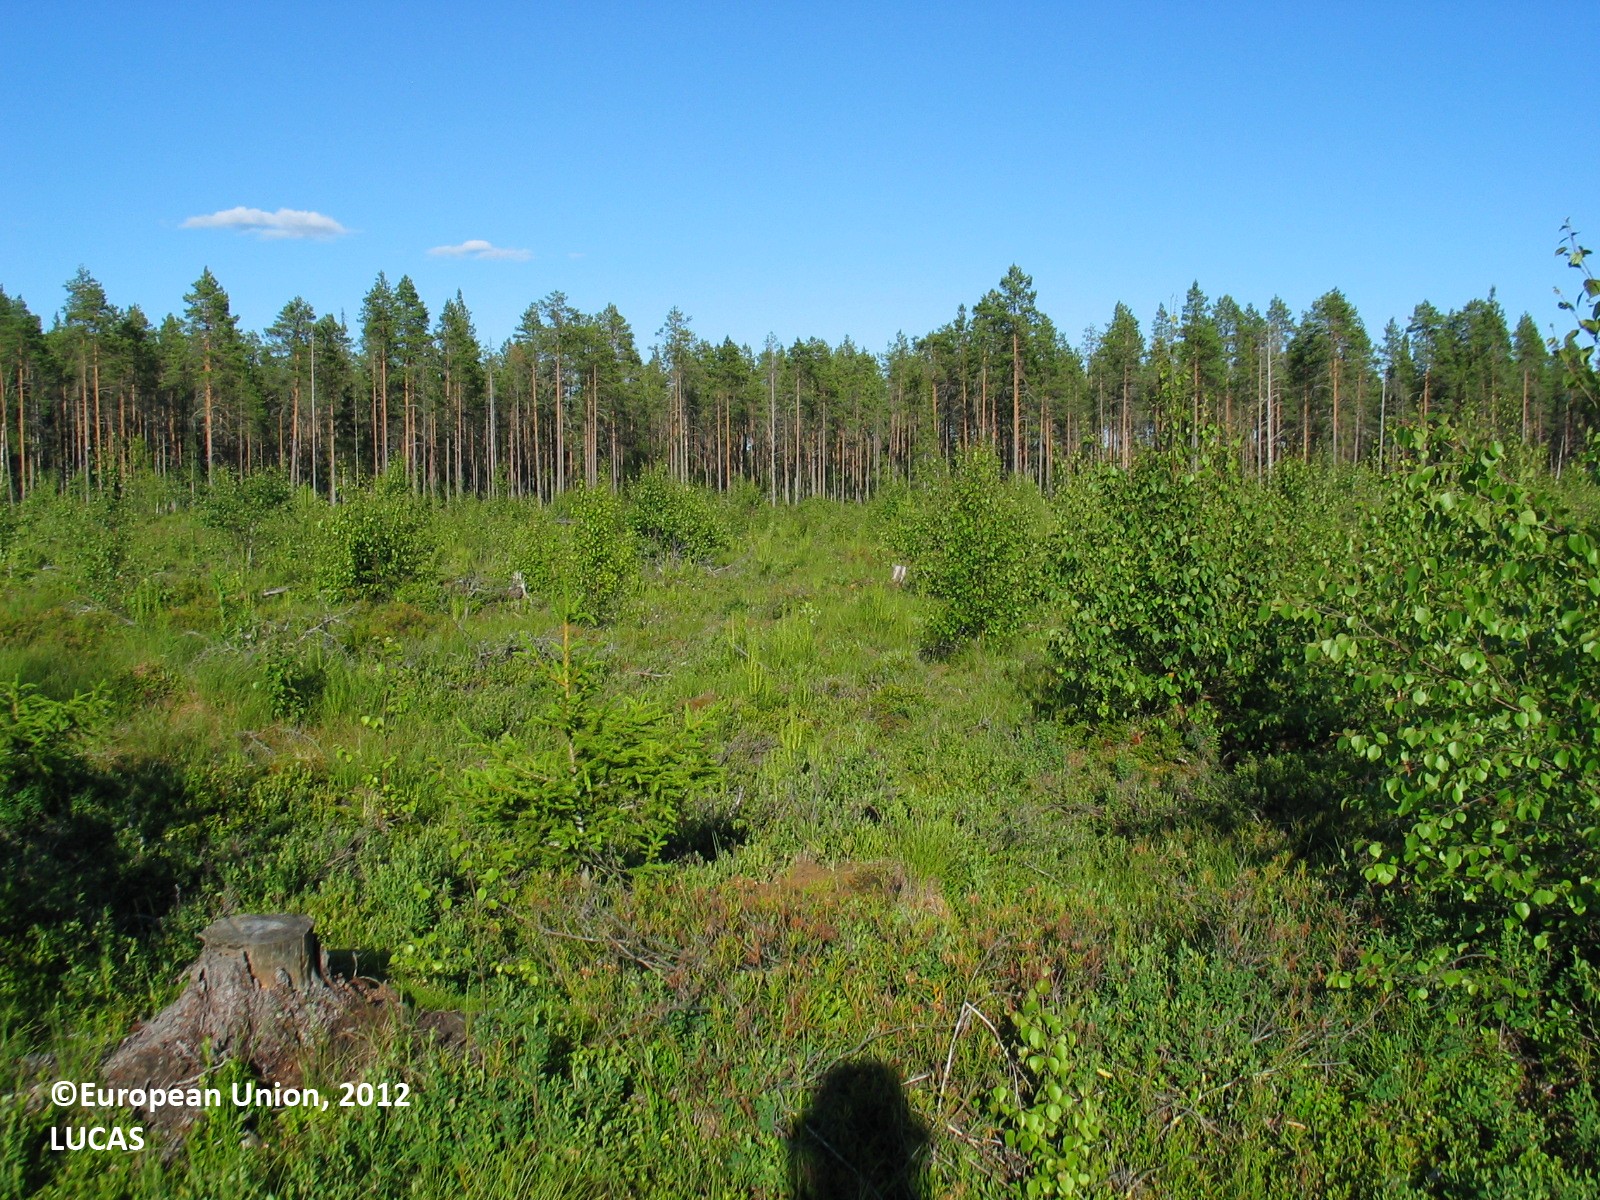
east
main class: Woodland
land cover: Other mixed woodland
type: boreal forest
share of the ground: 10 - 25 %
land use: Forestry
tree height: < 5 m
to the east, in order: Other mixed woodland; Ditches and canals; Other mixed woodland; Ditches and canals; Other mixed woodland; Ditches and canals; Other mixed woodland; Ditches and canals; Other mixed woodland; Ditches and canals; Other mixed woodland; Ditches and canals; Other mixed woodland; Pine dominated coniferous woodland; Ditches and canals; Broadleaved woodland; Tracks; Broadleaved woodland; Ditches and canals; Other mixed woodland; Ditches and canals; Other mixed woodland
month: July
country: FI
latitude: 64.6865
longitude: 26.5687
